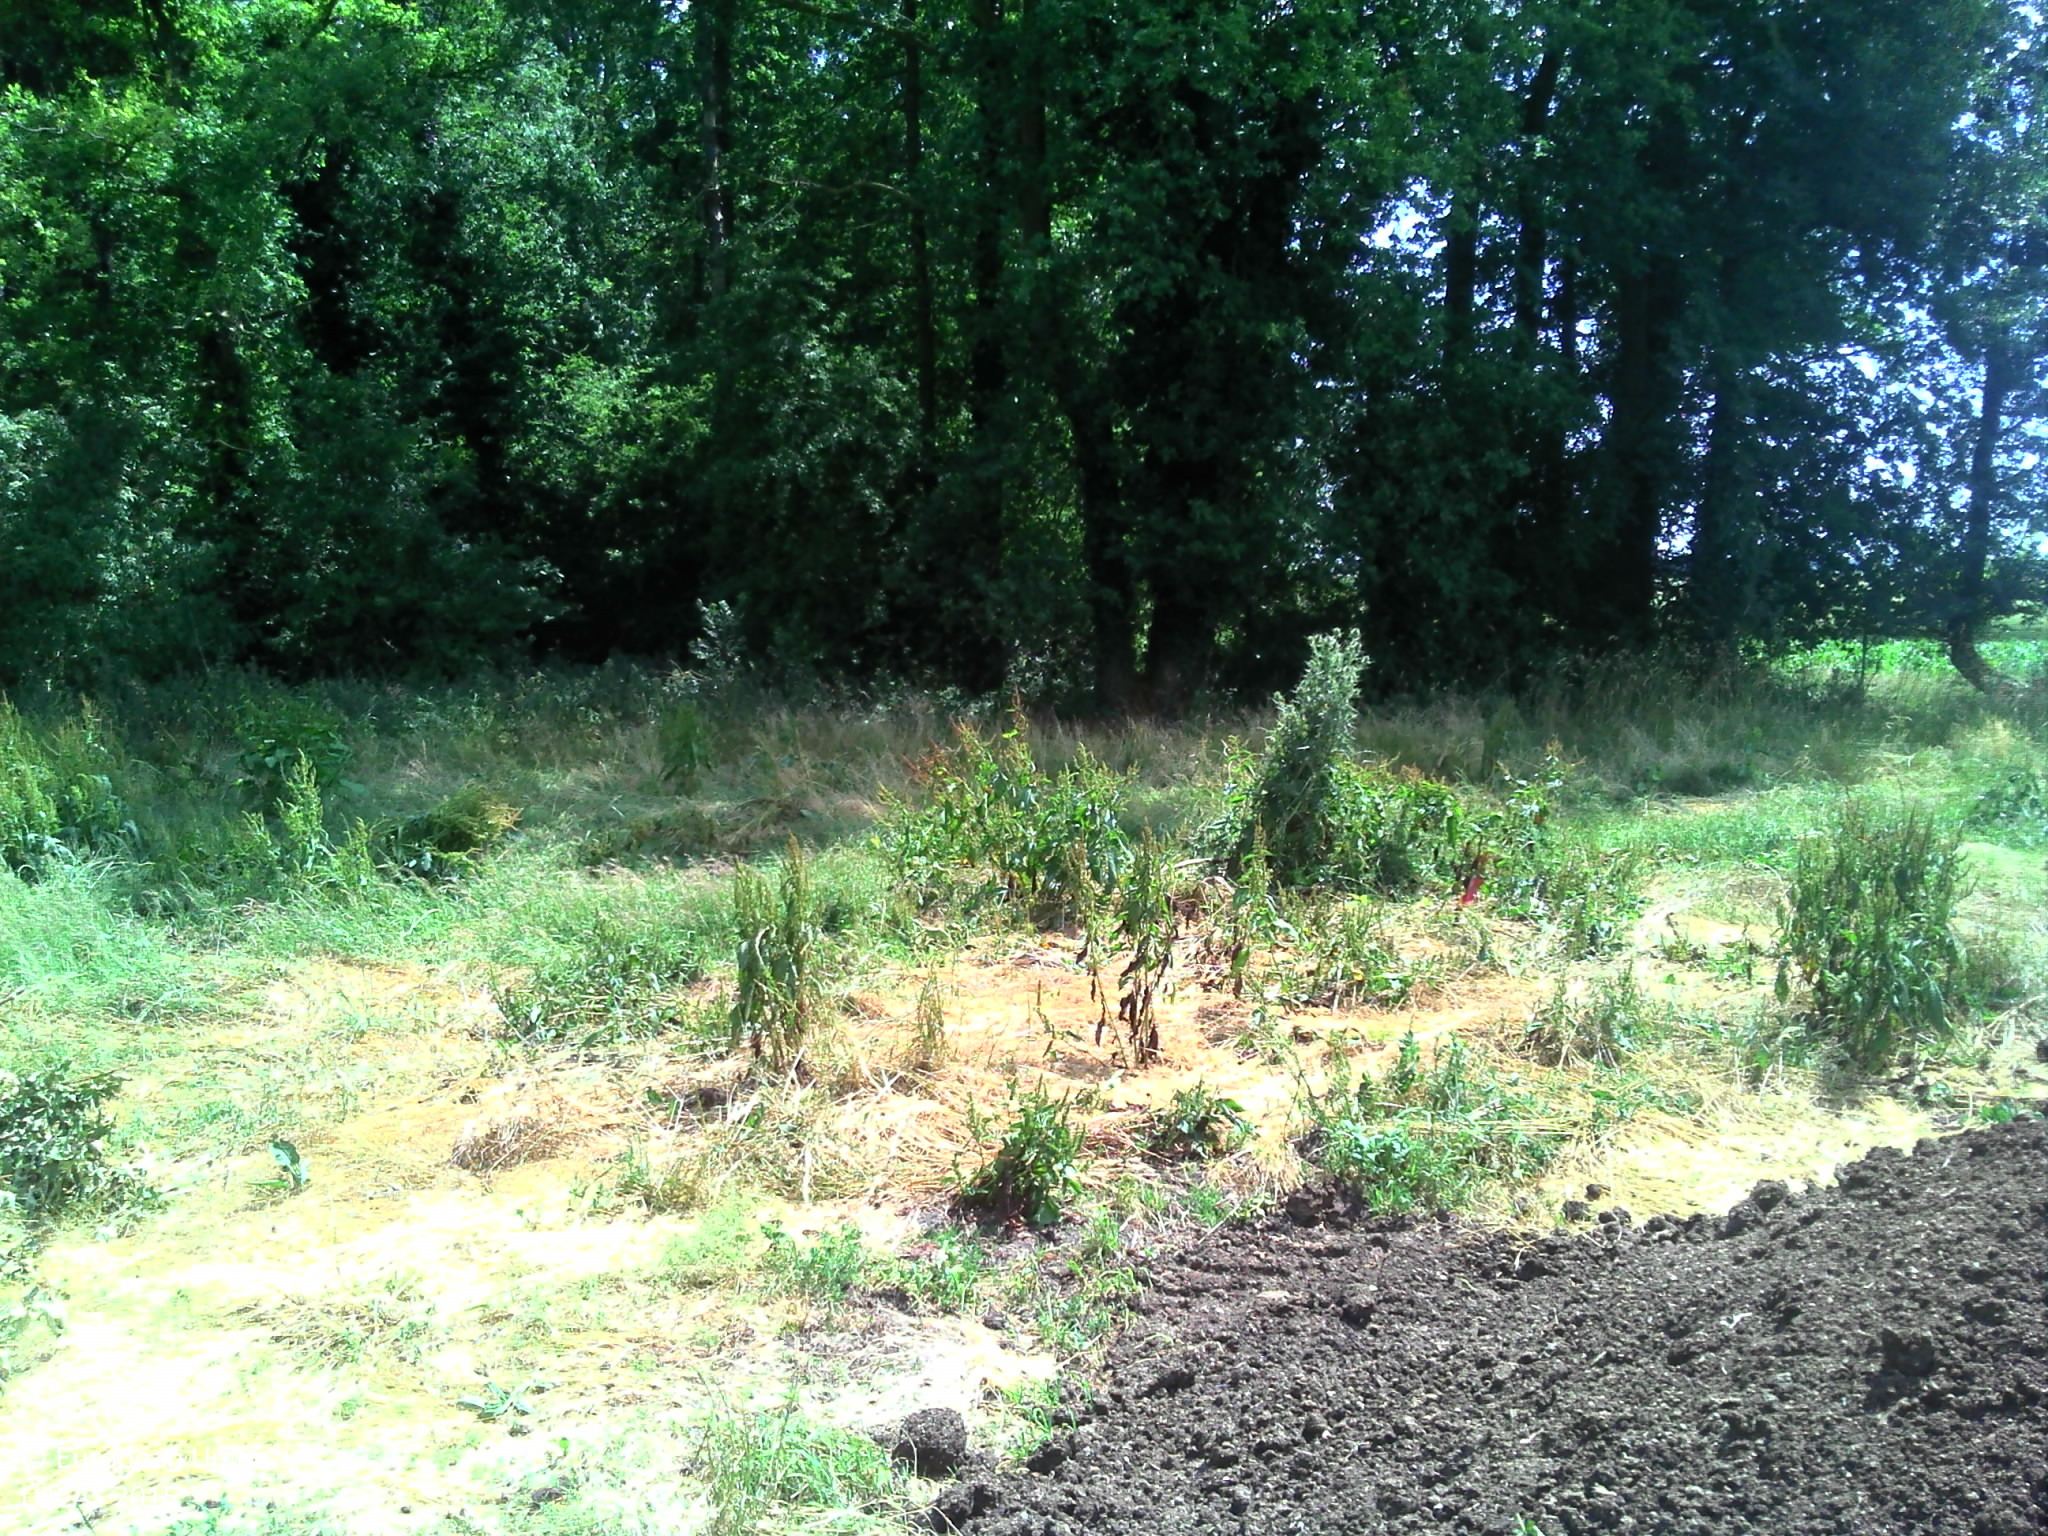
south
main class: Cropland
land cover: Rape and turnip rape
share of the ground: > 75 %
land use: Agriculture (excluding fallow land and kitchen gardens)
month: June
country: FR
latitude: 49.0682
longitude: 1.2338
